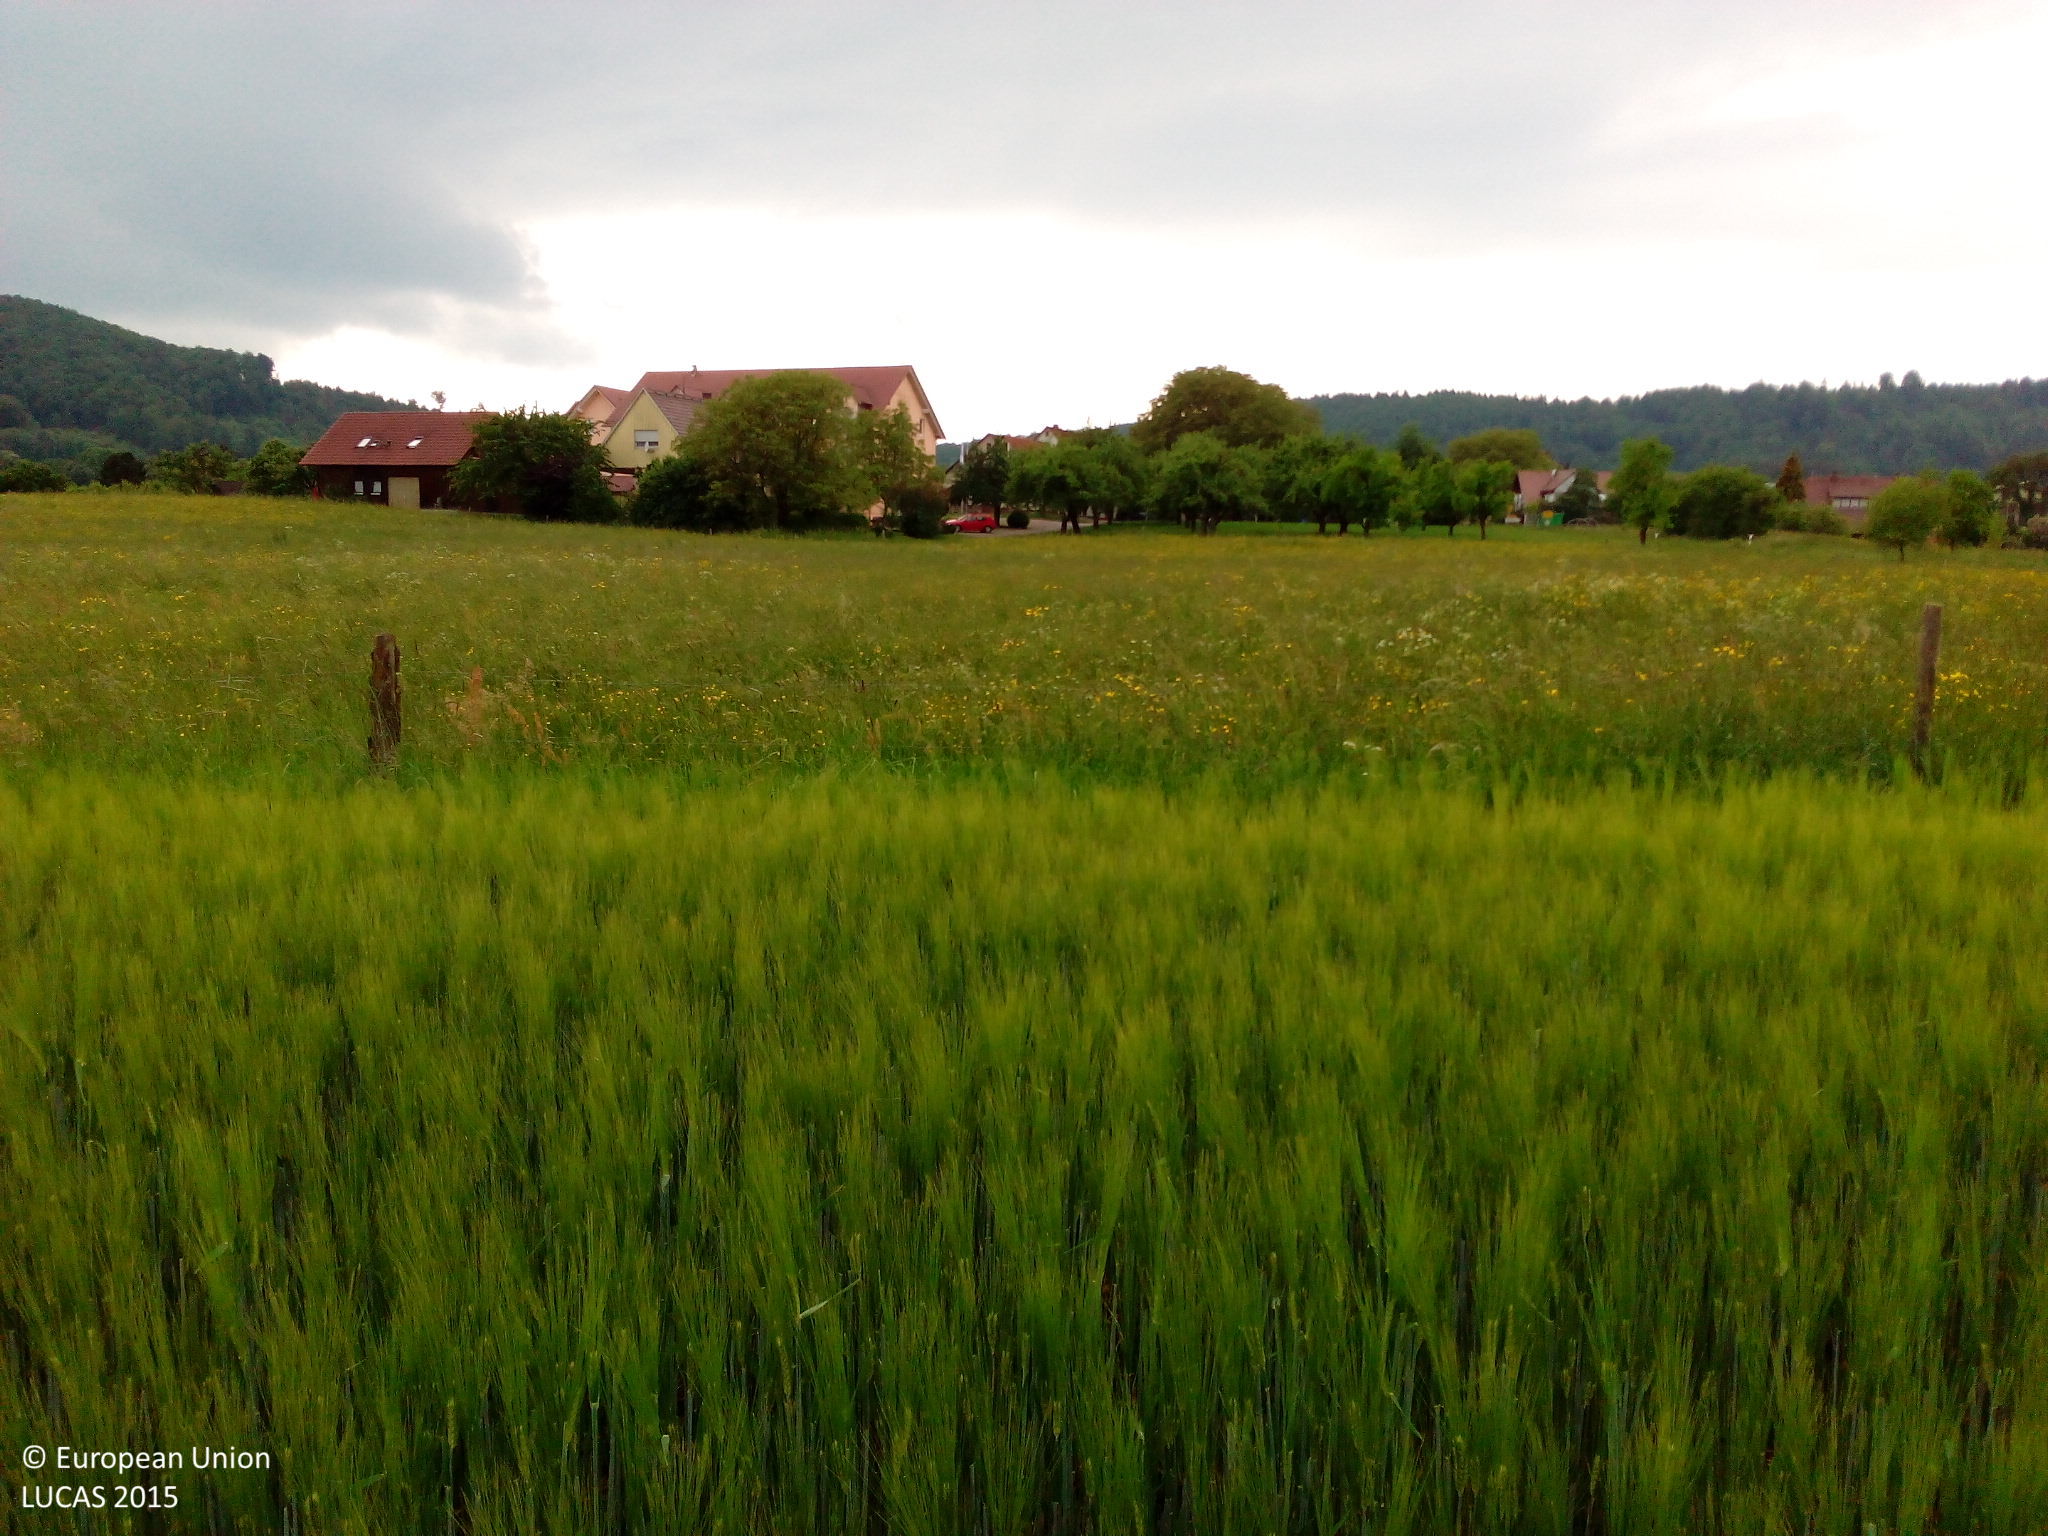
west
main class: Cropland
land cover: Barley
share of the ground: > 75 %
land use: Agriculture (excluding fallow land and kitchen gardens)
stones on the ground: < 10 %
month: May
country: DE
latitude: 49.1766
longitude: 9.6846
